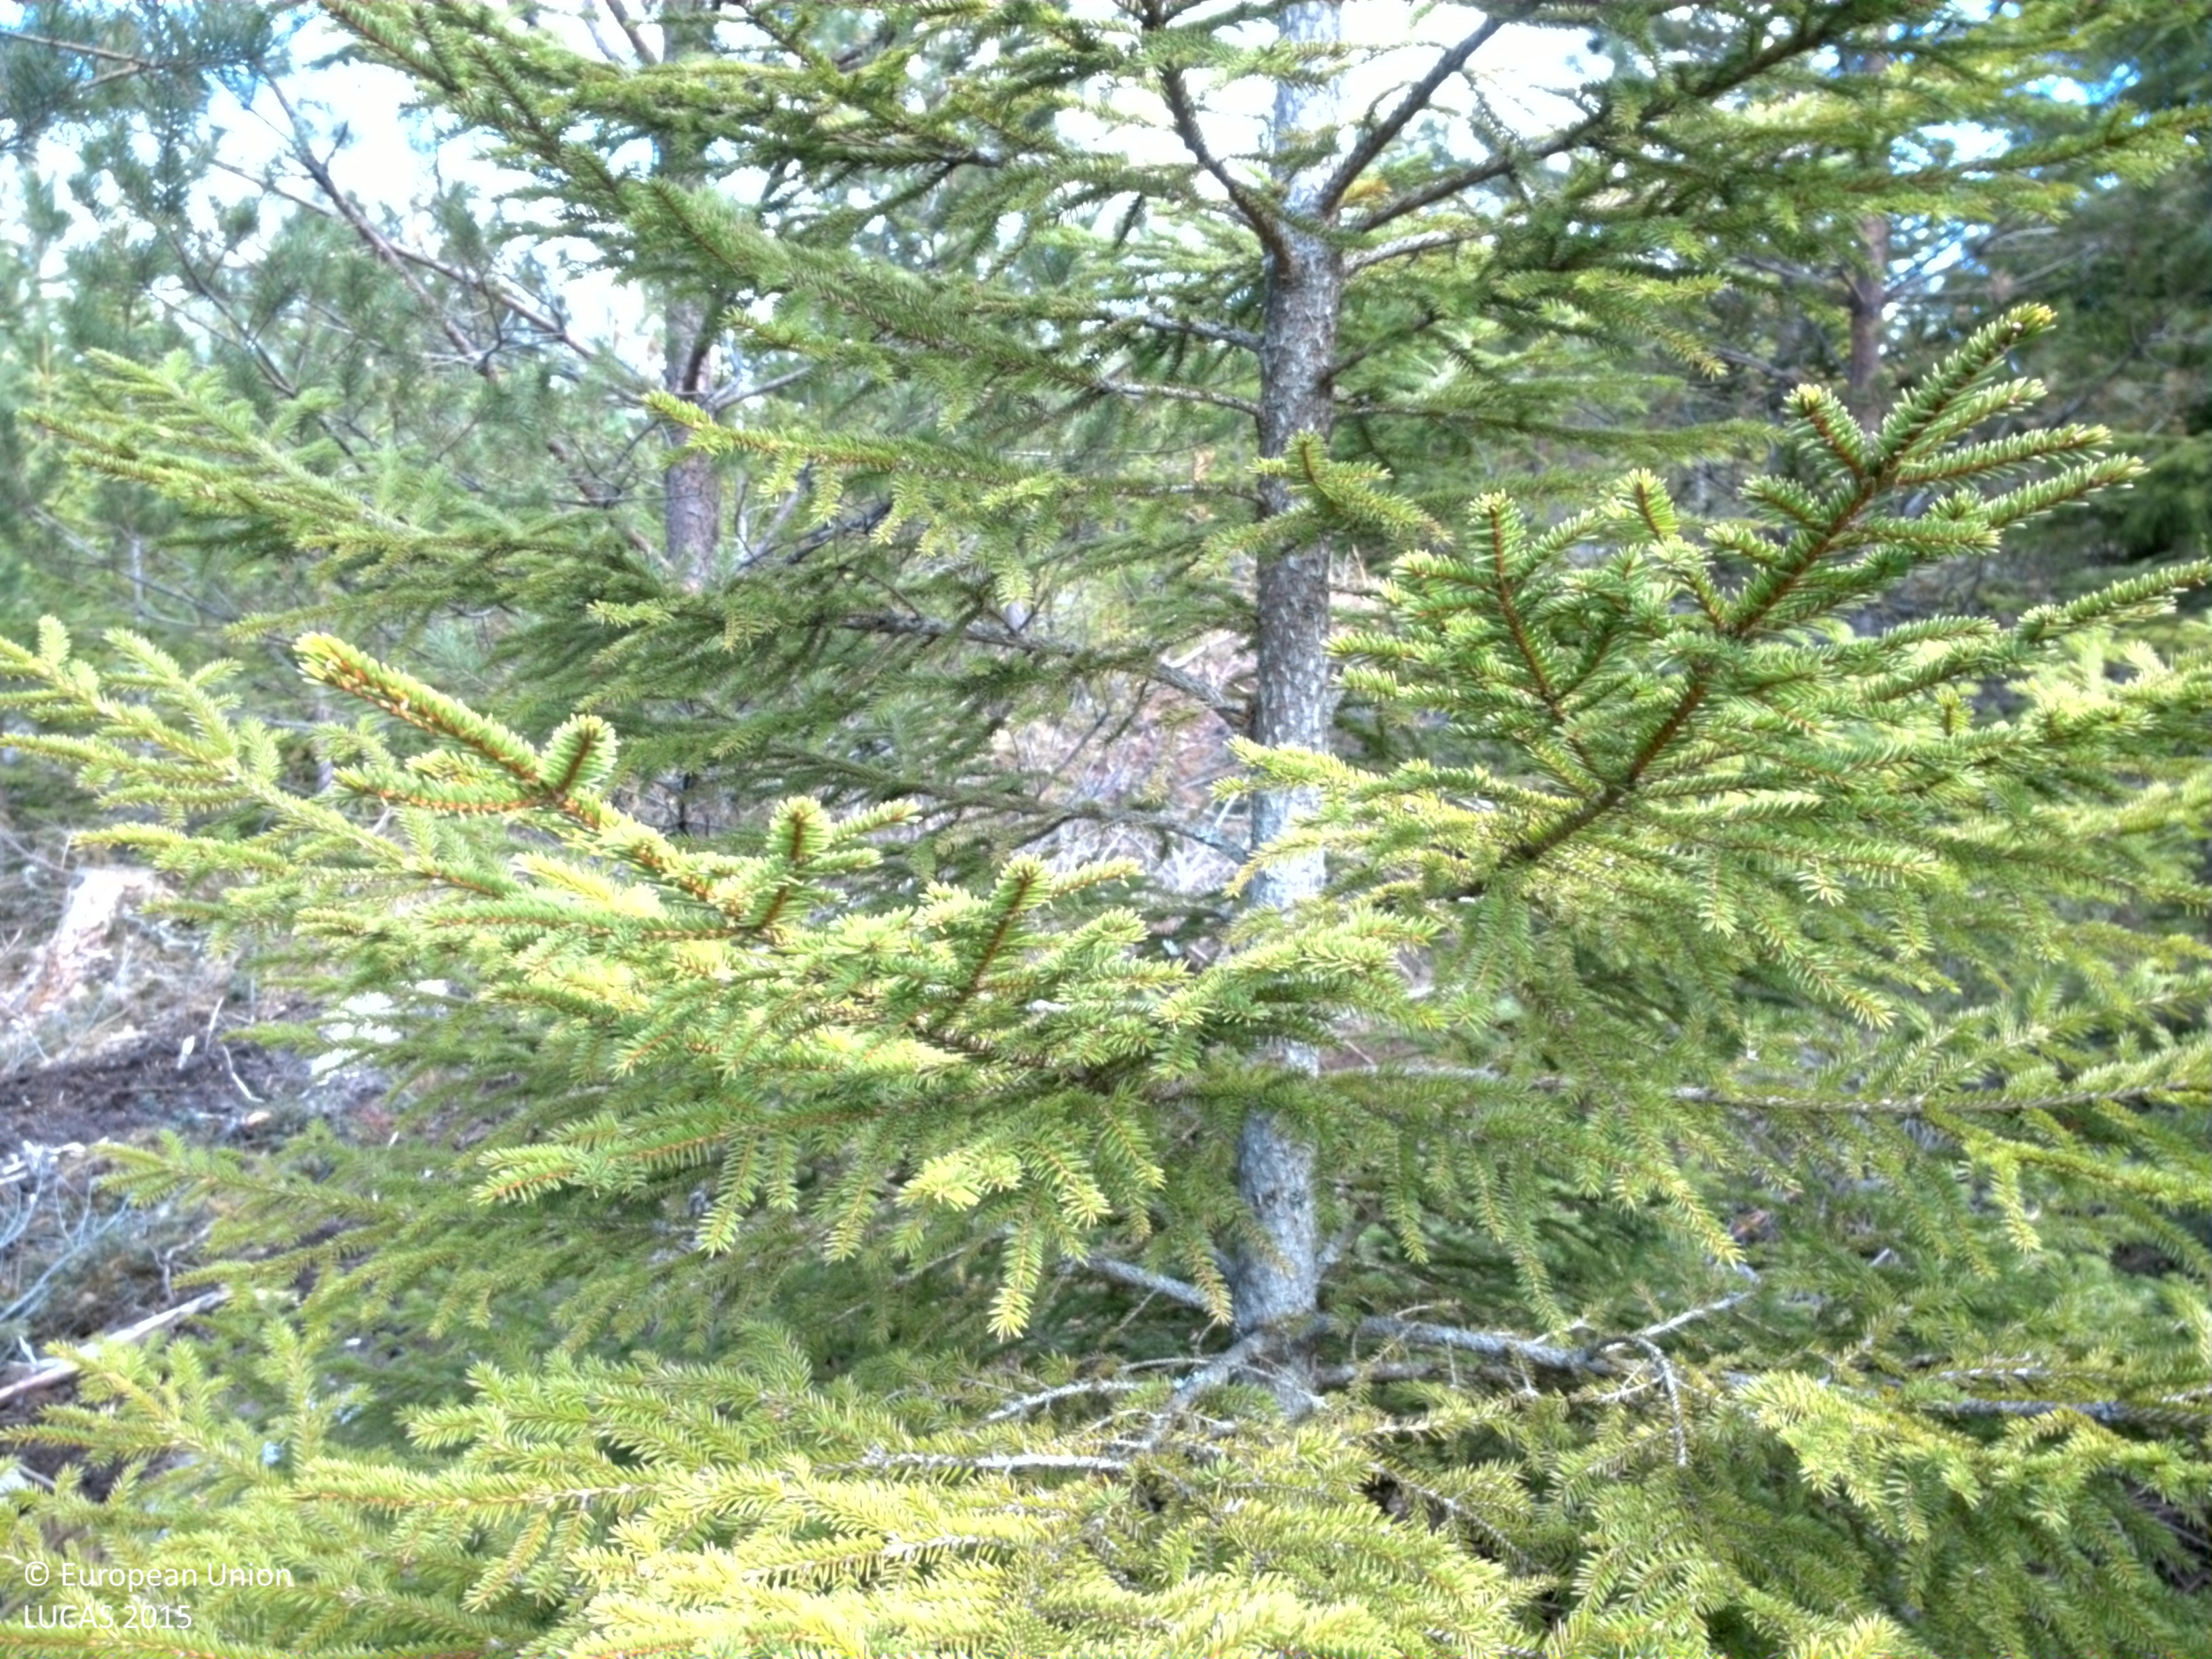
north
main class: Woodland
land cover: Other coniferous woodland
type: boreal forest
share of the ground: > 75 %
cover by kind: coniferous forest trees 75 %, shrubs 10 %, lichens and mosses 10 %, consolidated bare surface 5 %
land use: Forestry
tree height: > 5 m
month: May
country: SE
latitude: 59.2301
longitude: 14.3553
